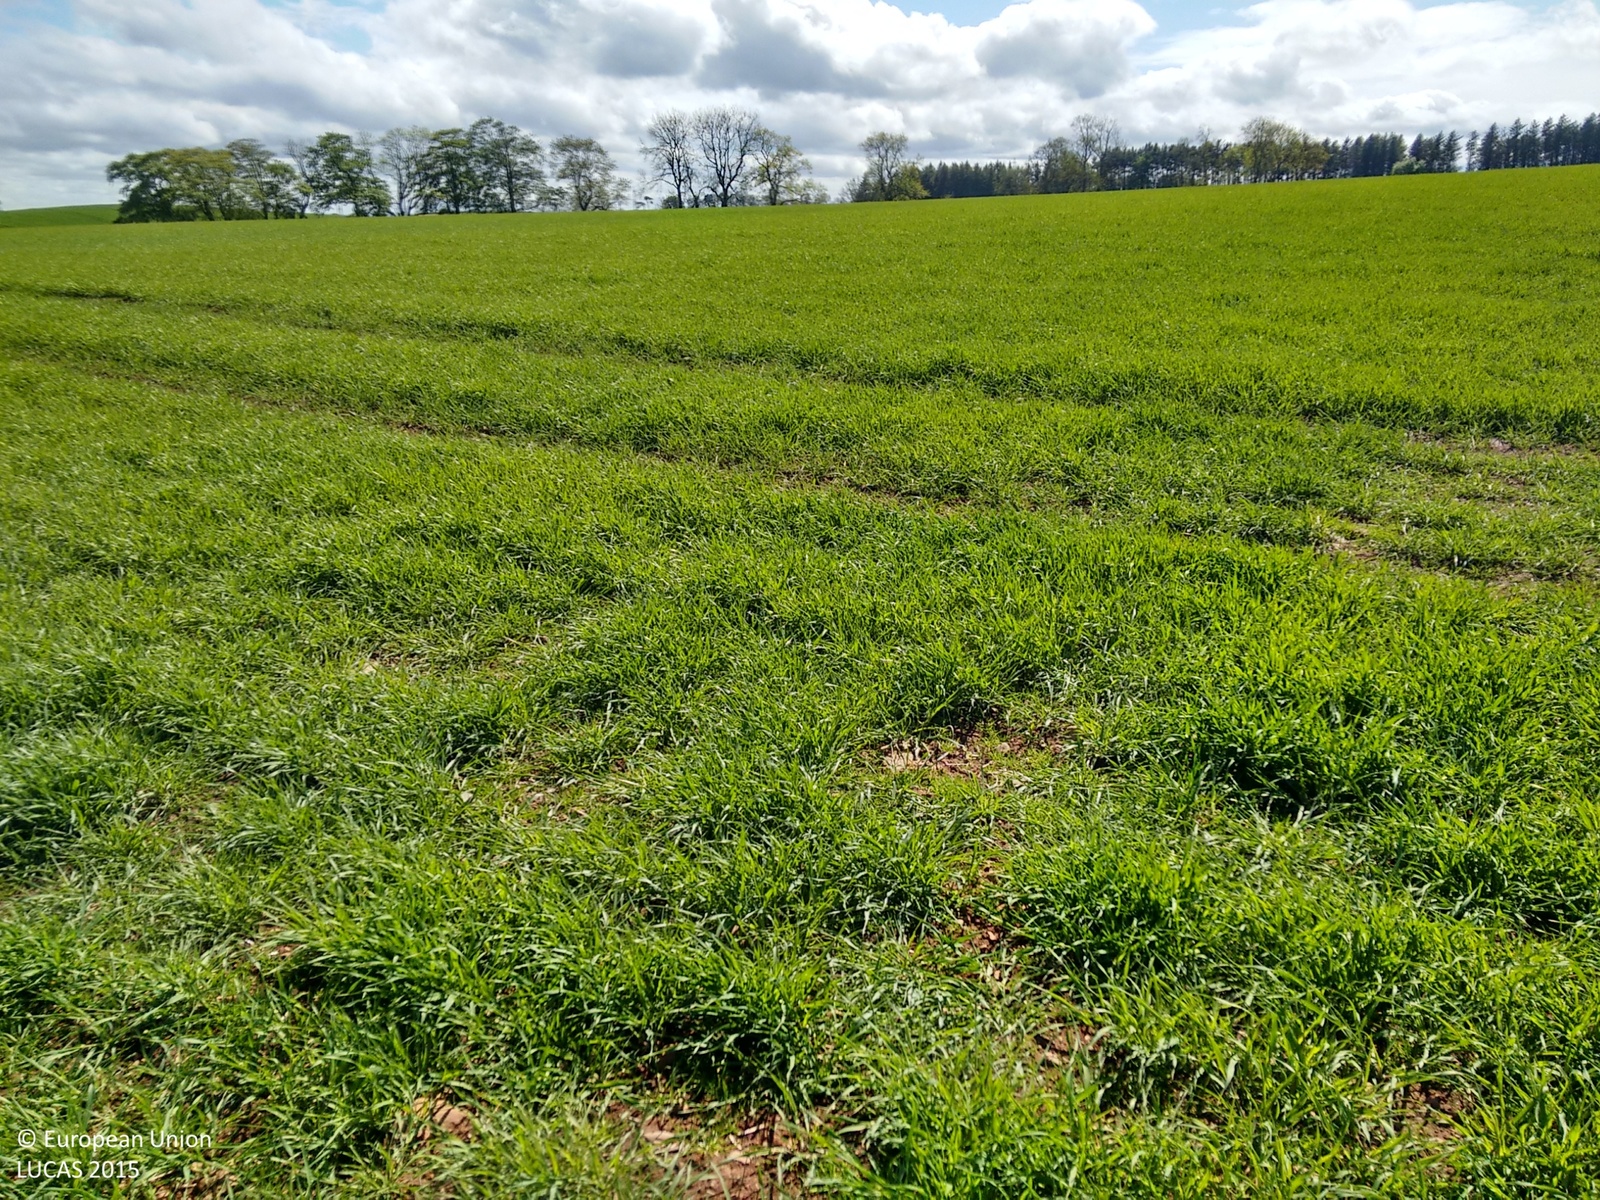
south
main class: Cropland
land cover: Barley
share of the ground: > 75 %
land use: Agriculture (excluding fallow land and kitchen gardens)
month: June
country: GB
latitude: 55.6877
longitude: -2.4508
